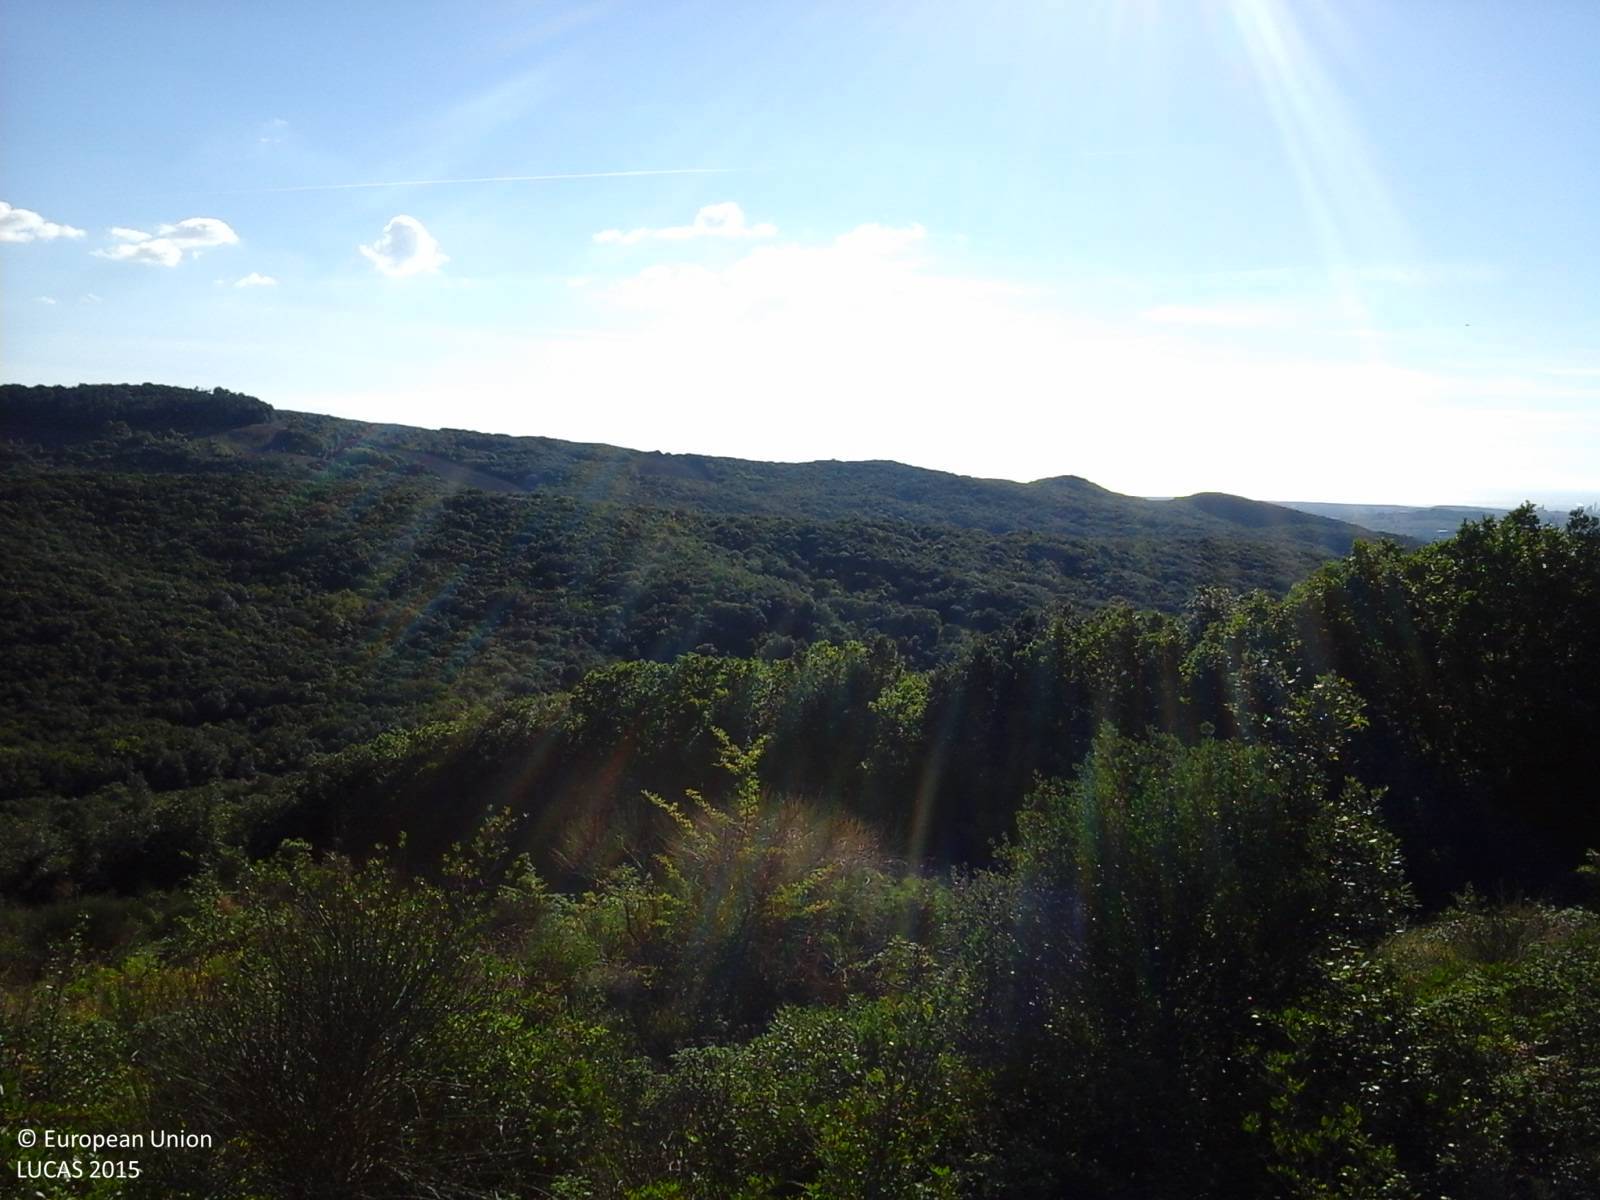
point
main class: Woodland
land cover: Broadleaved woodland
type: thermophilous deciduous forest
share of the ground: > 75 %
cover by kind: broadleaved forest trees 80 %, shrubs 20 %
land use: Forestry
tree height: > 5 m
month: October
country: IT
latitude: 43.4108
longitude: 10.5541
